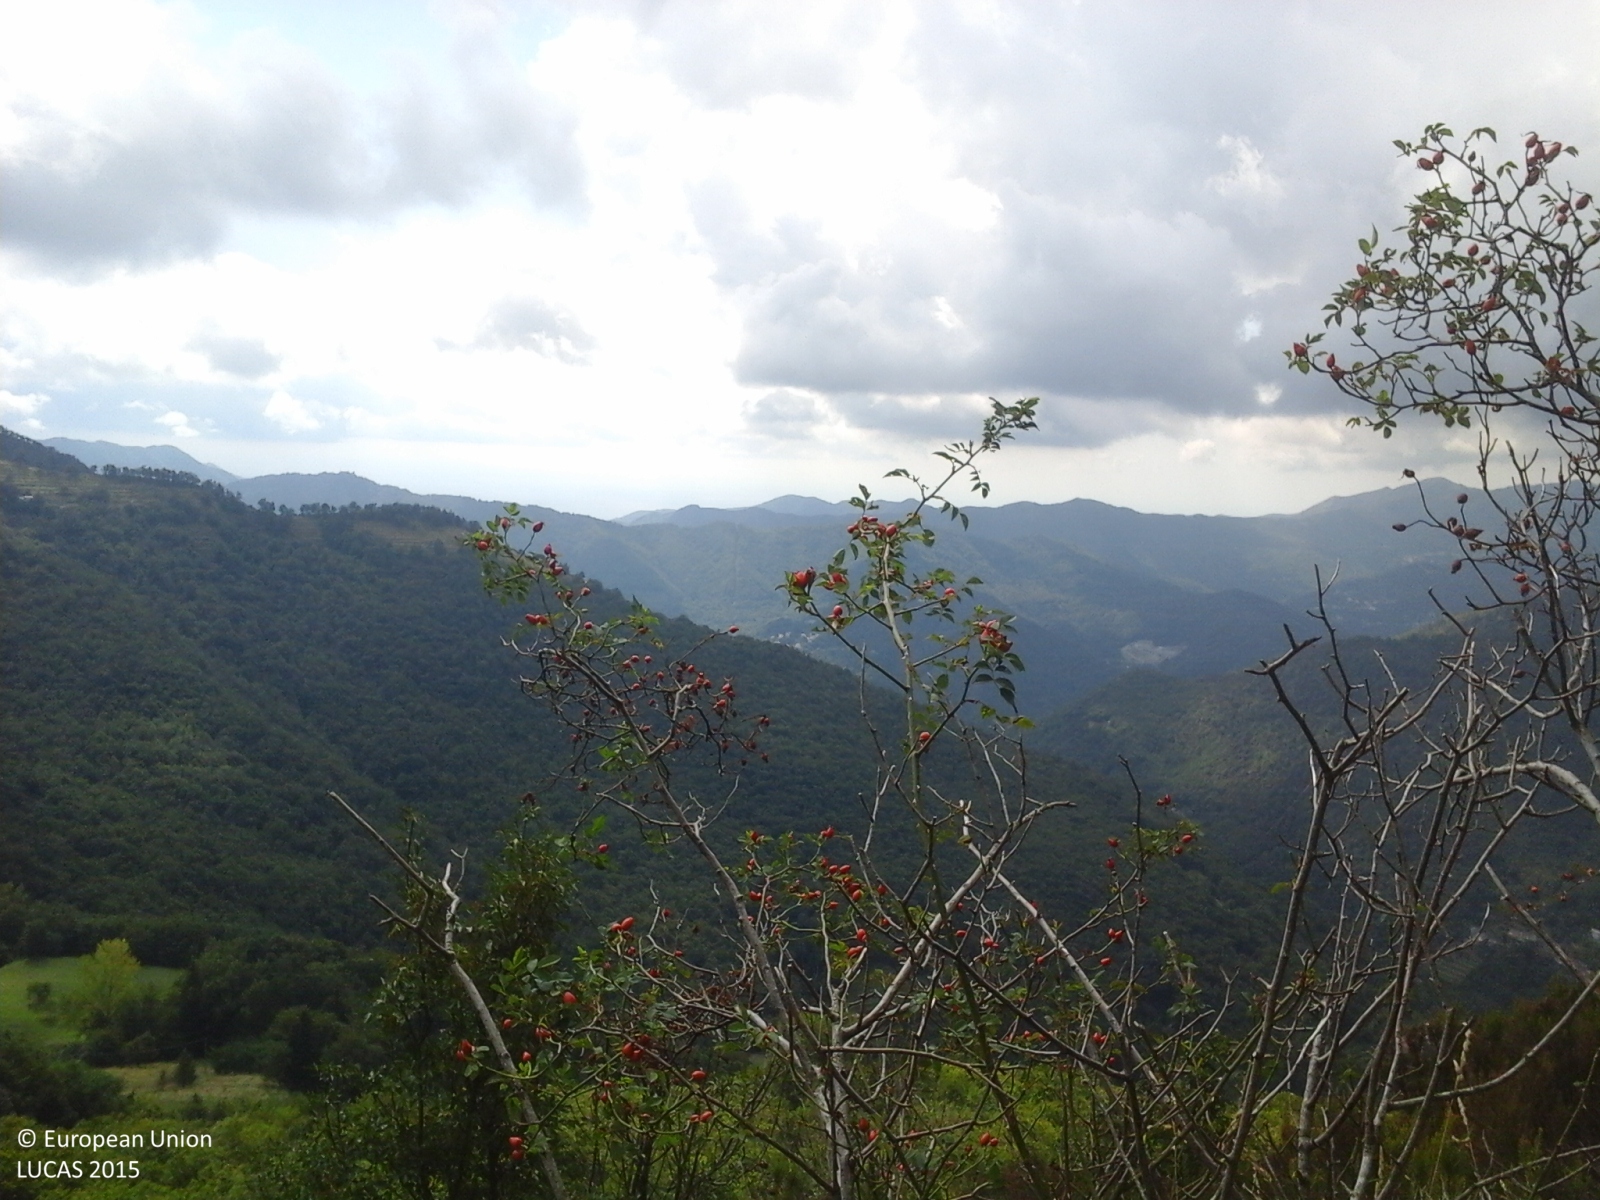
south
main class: Woodland
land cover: Broadleaved woodland
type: thermophilous deciduous forest
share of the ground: > 75 %
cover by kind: broadleaved forest trees 100 %
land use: Forestry
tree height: > 5 m
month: September
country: IT
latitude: 44.4558
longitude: 9.2100
